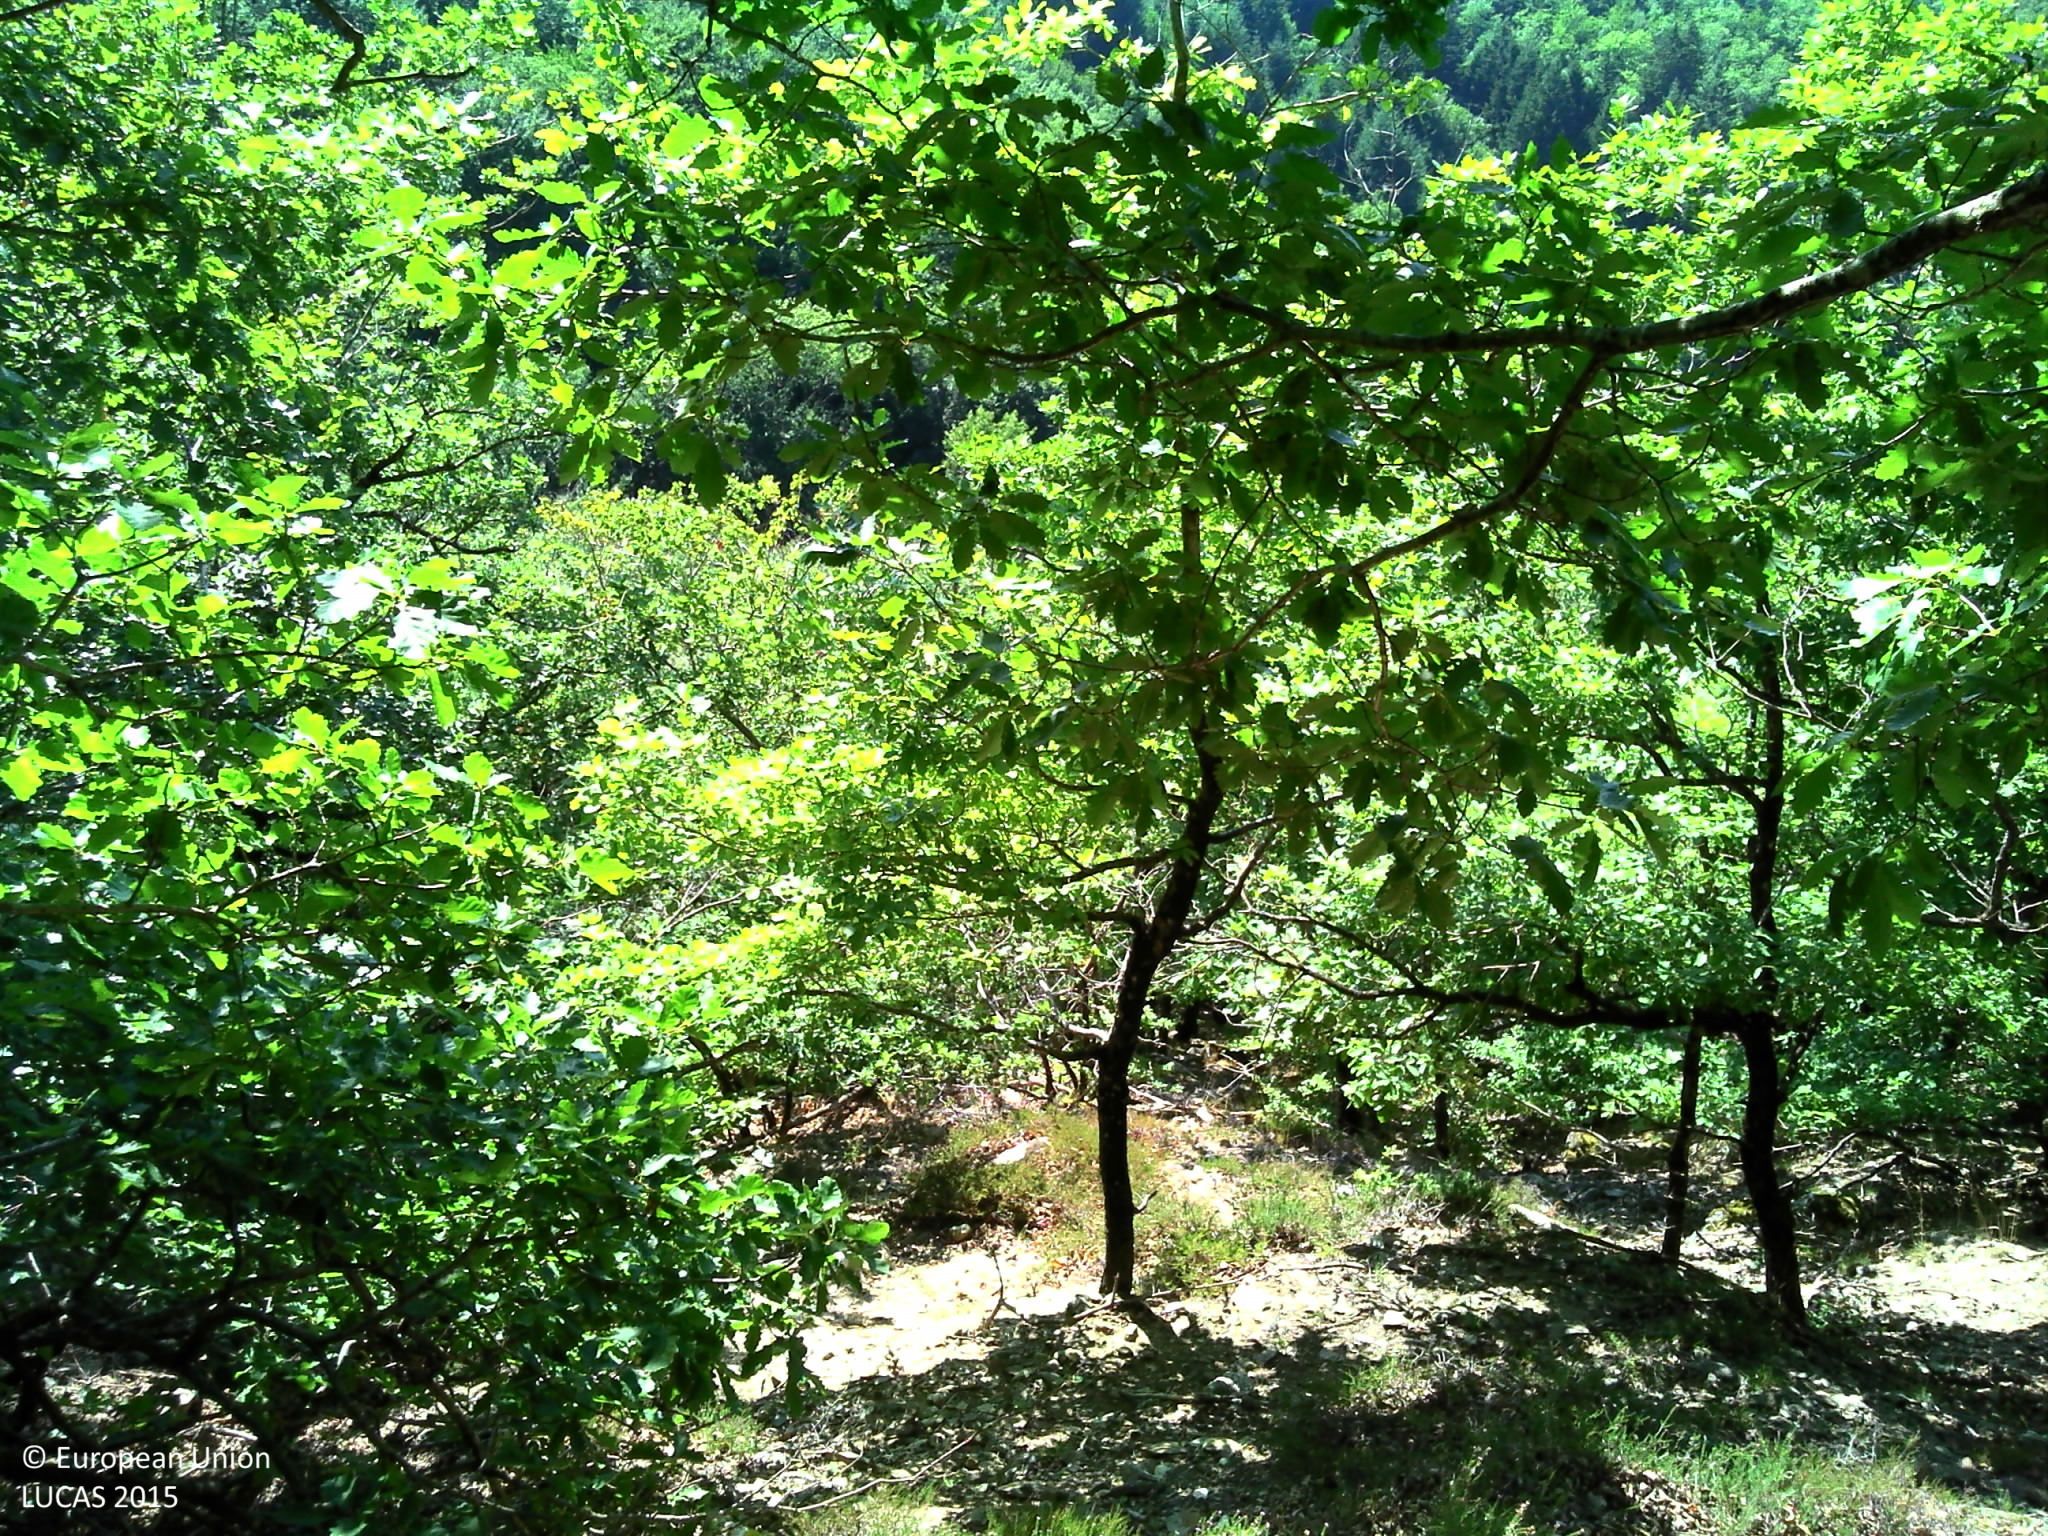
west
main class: Woodland
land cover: Broadleaved woodland
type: acidophilous oak and oak-birch forest
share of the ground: > 75 %
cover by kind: broadleaved forest trees 90 %, herbaceous plants 5 %, lichens and mosses 5 %
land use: Forestry
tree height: > 5 m
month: August
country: FR
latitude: 43.7727
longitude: 3.0376
